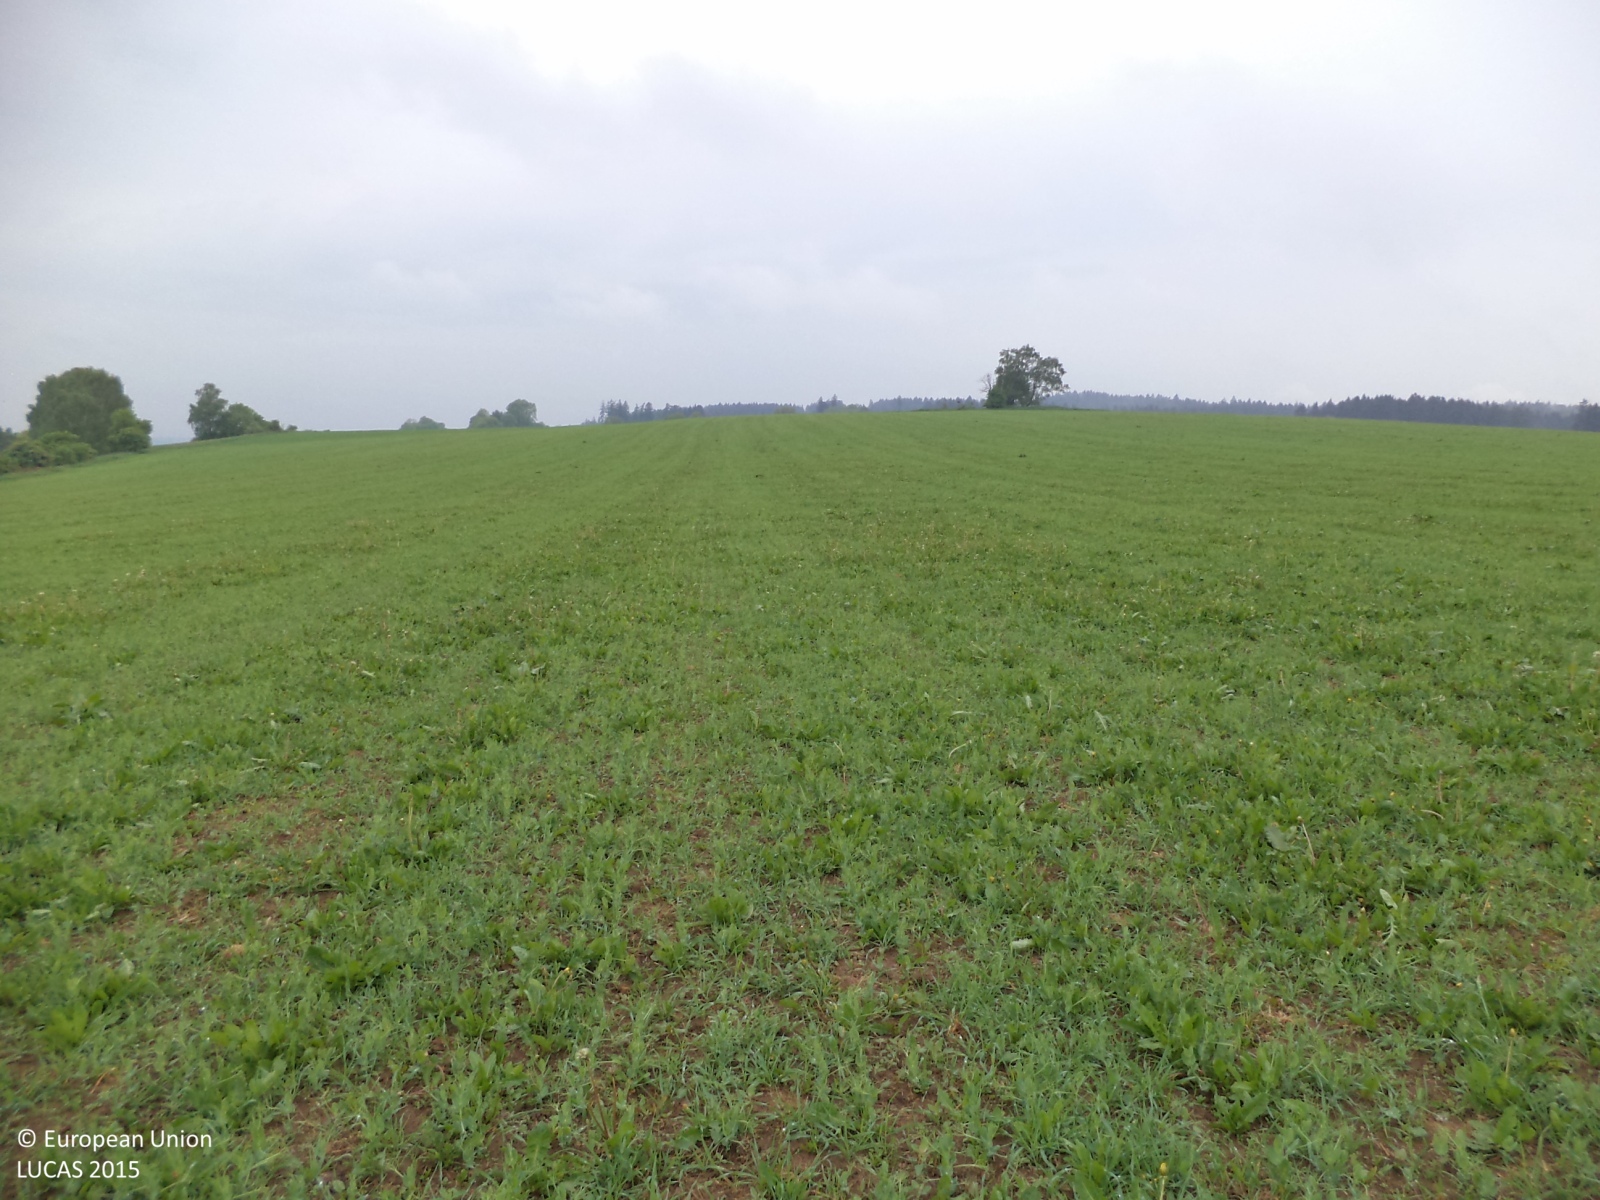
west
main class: Cropland
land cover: Other leguminous and mixtures for fodder
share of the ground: > 75 %
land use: Agriculture (excluding fallow land and kitchen gardens)
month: May
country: CZ
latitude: 49.4113
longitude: 14.9228
